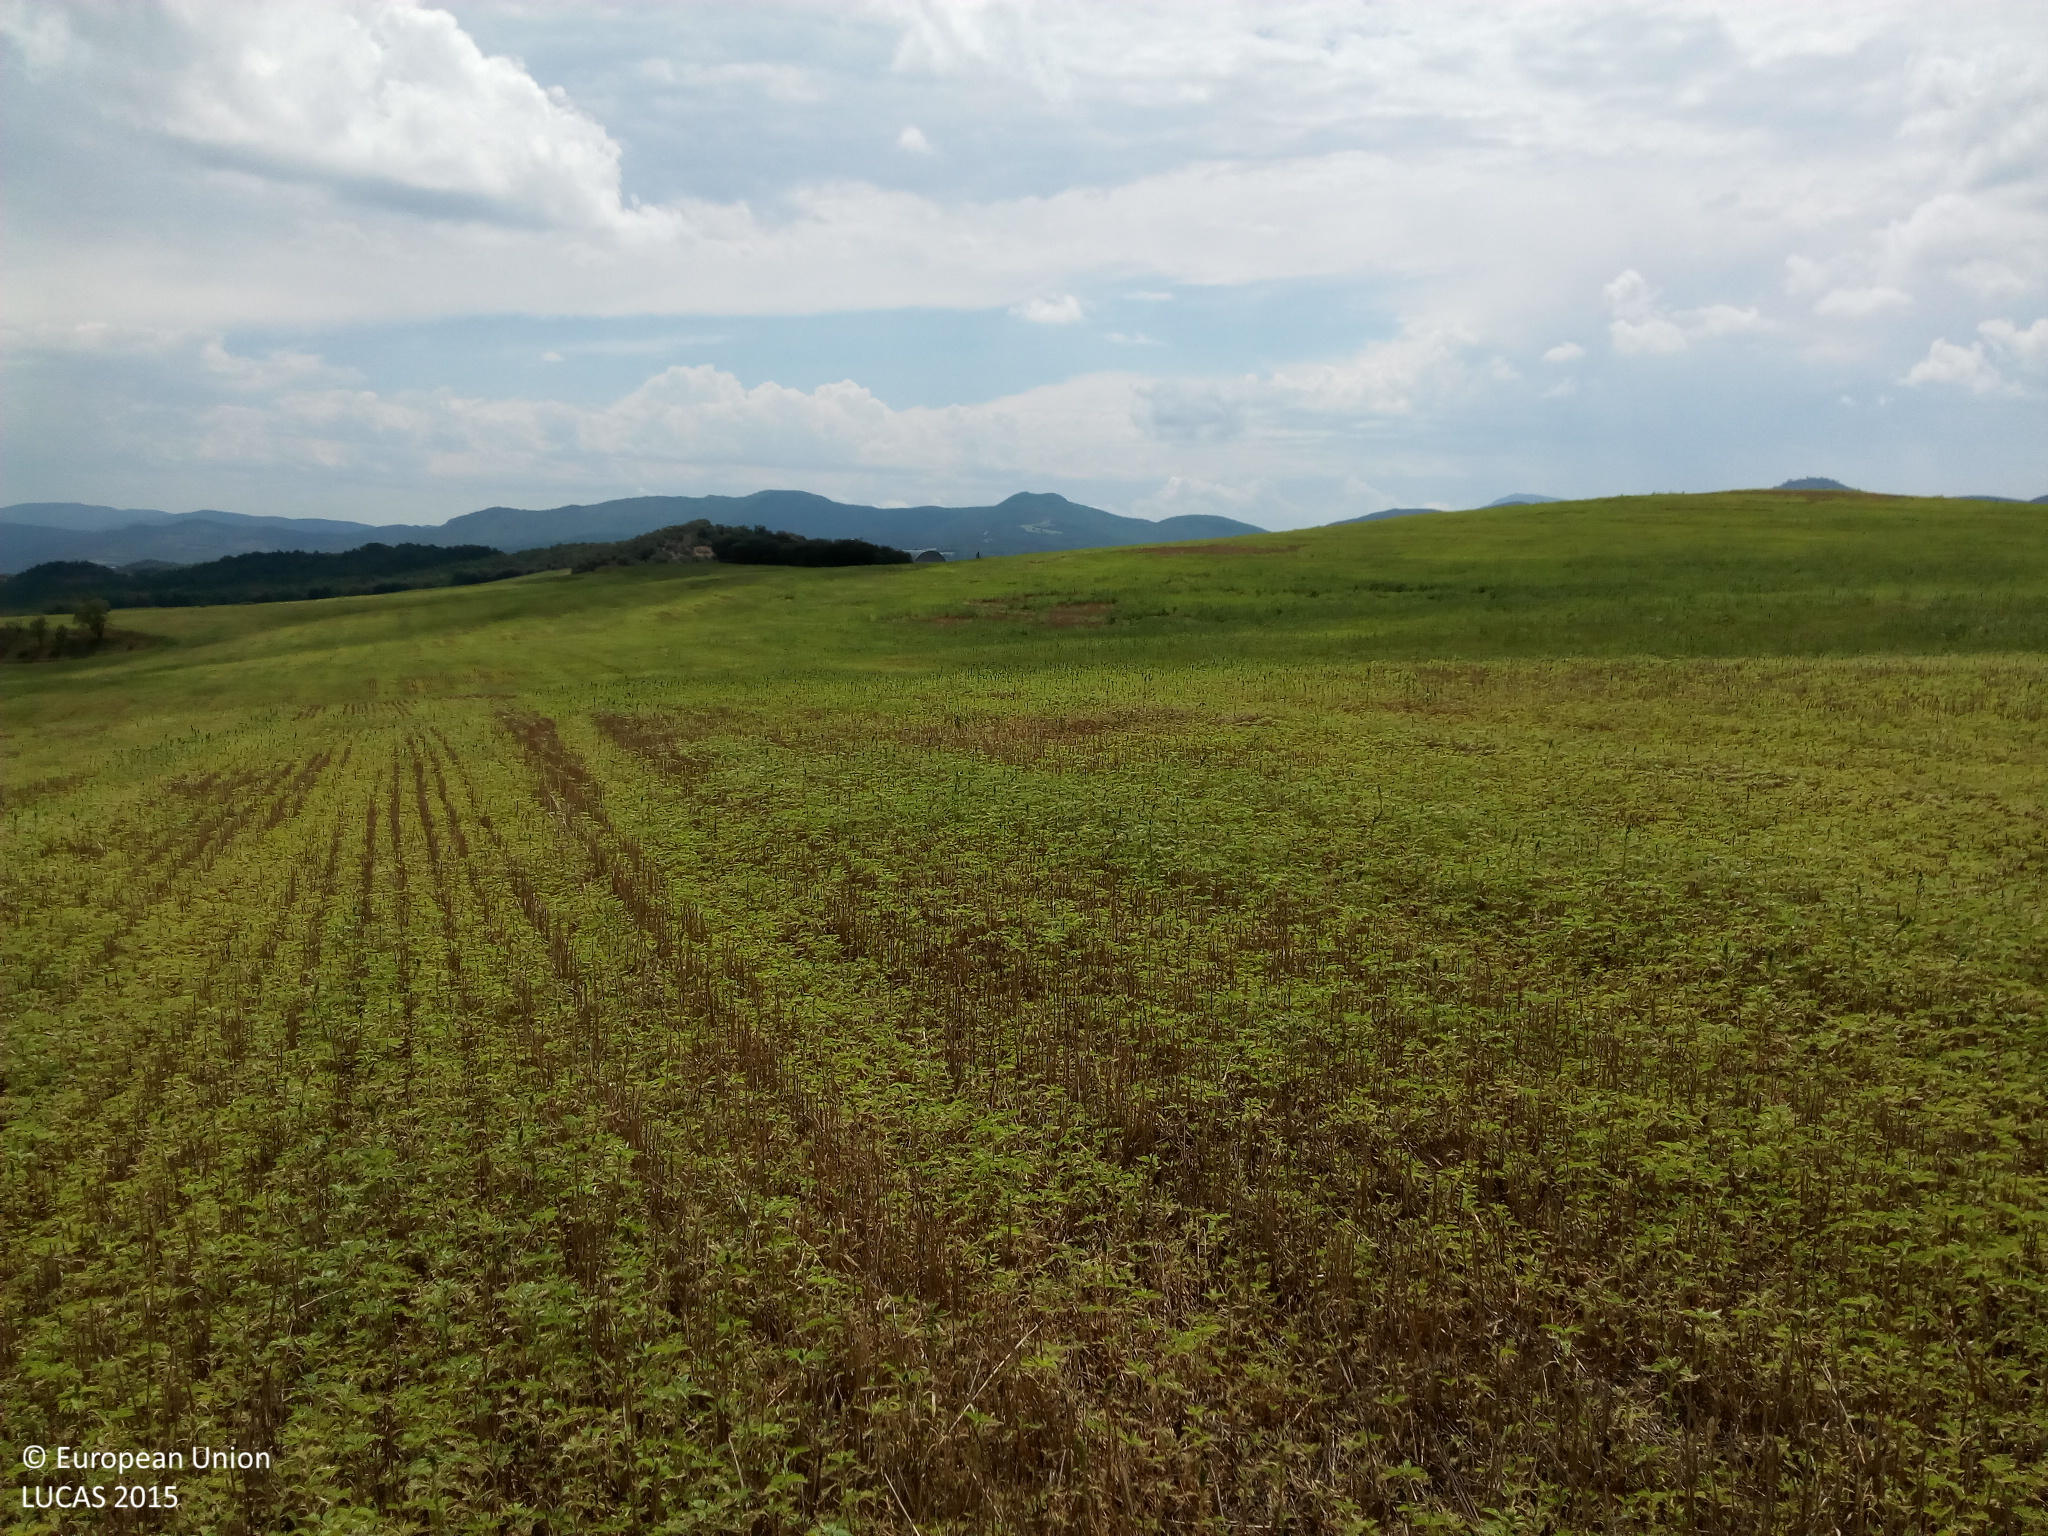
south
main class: Grassland
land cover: Spontaneously vegetated surfaces
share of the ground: > 75 %
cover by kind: herbaceous plants 100 %
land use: Fallow land
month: August
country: ES
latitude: 42.0990
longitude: 0.5157
